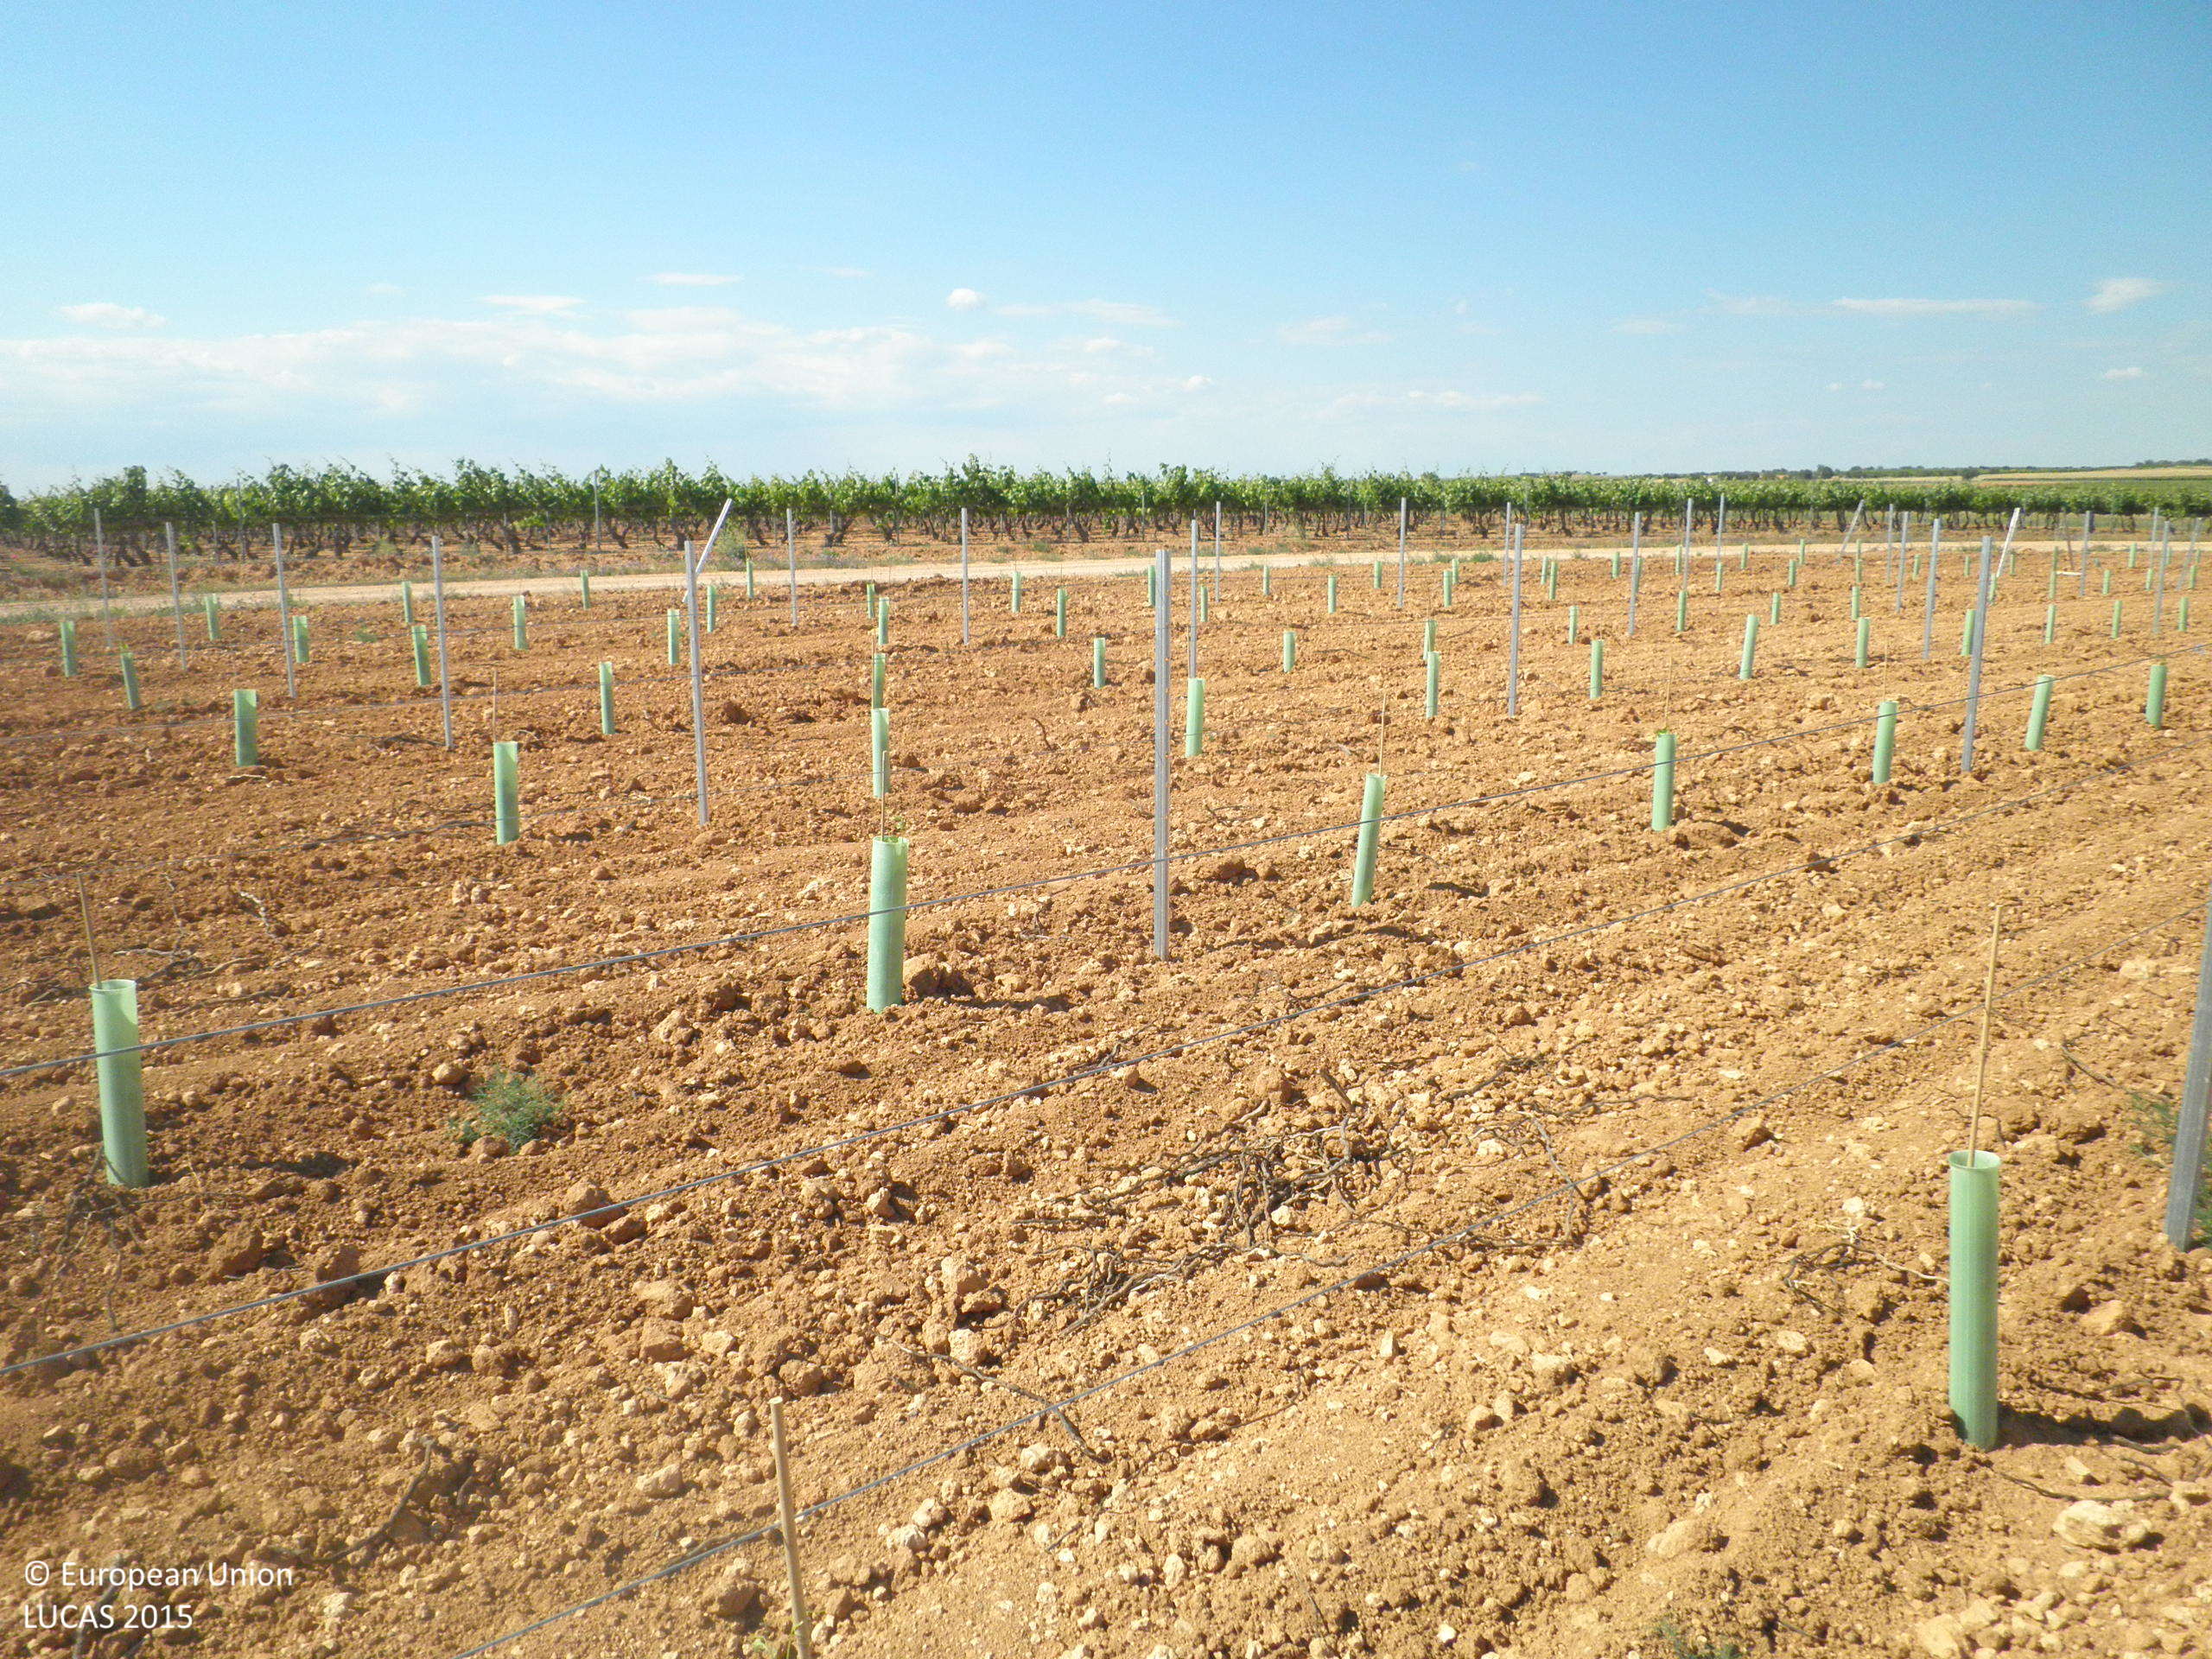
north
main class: Cropland
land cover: Vineyards
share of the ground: < 10 %
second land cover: Other bare soil
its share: > 75 %
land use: Agriculture (excluding fallow land and kitchen gardens)
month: June
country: ES
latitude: 39.4280
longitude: -1.7731
